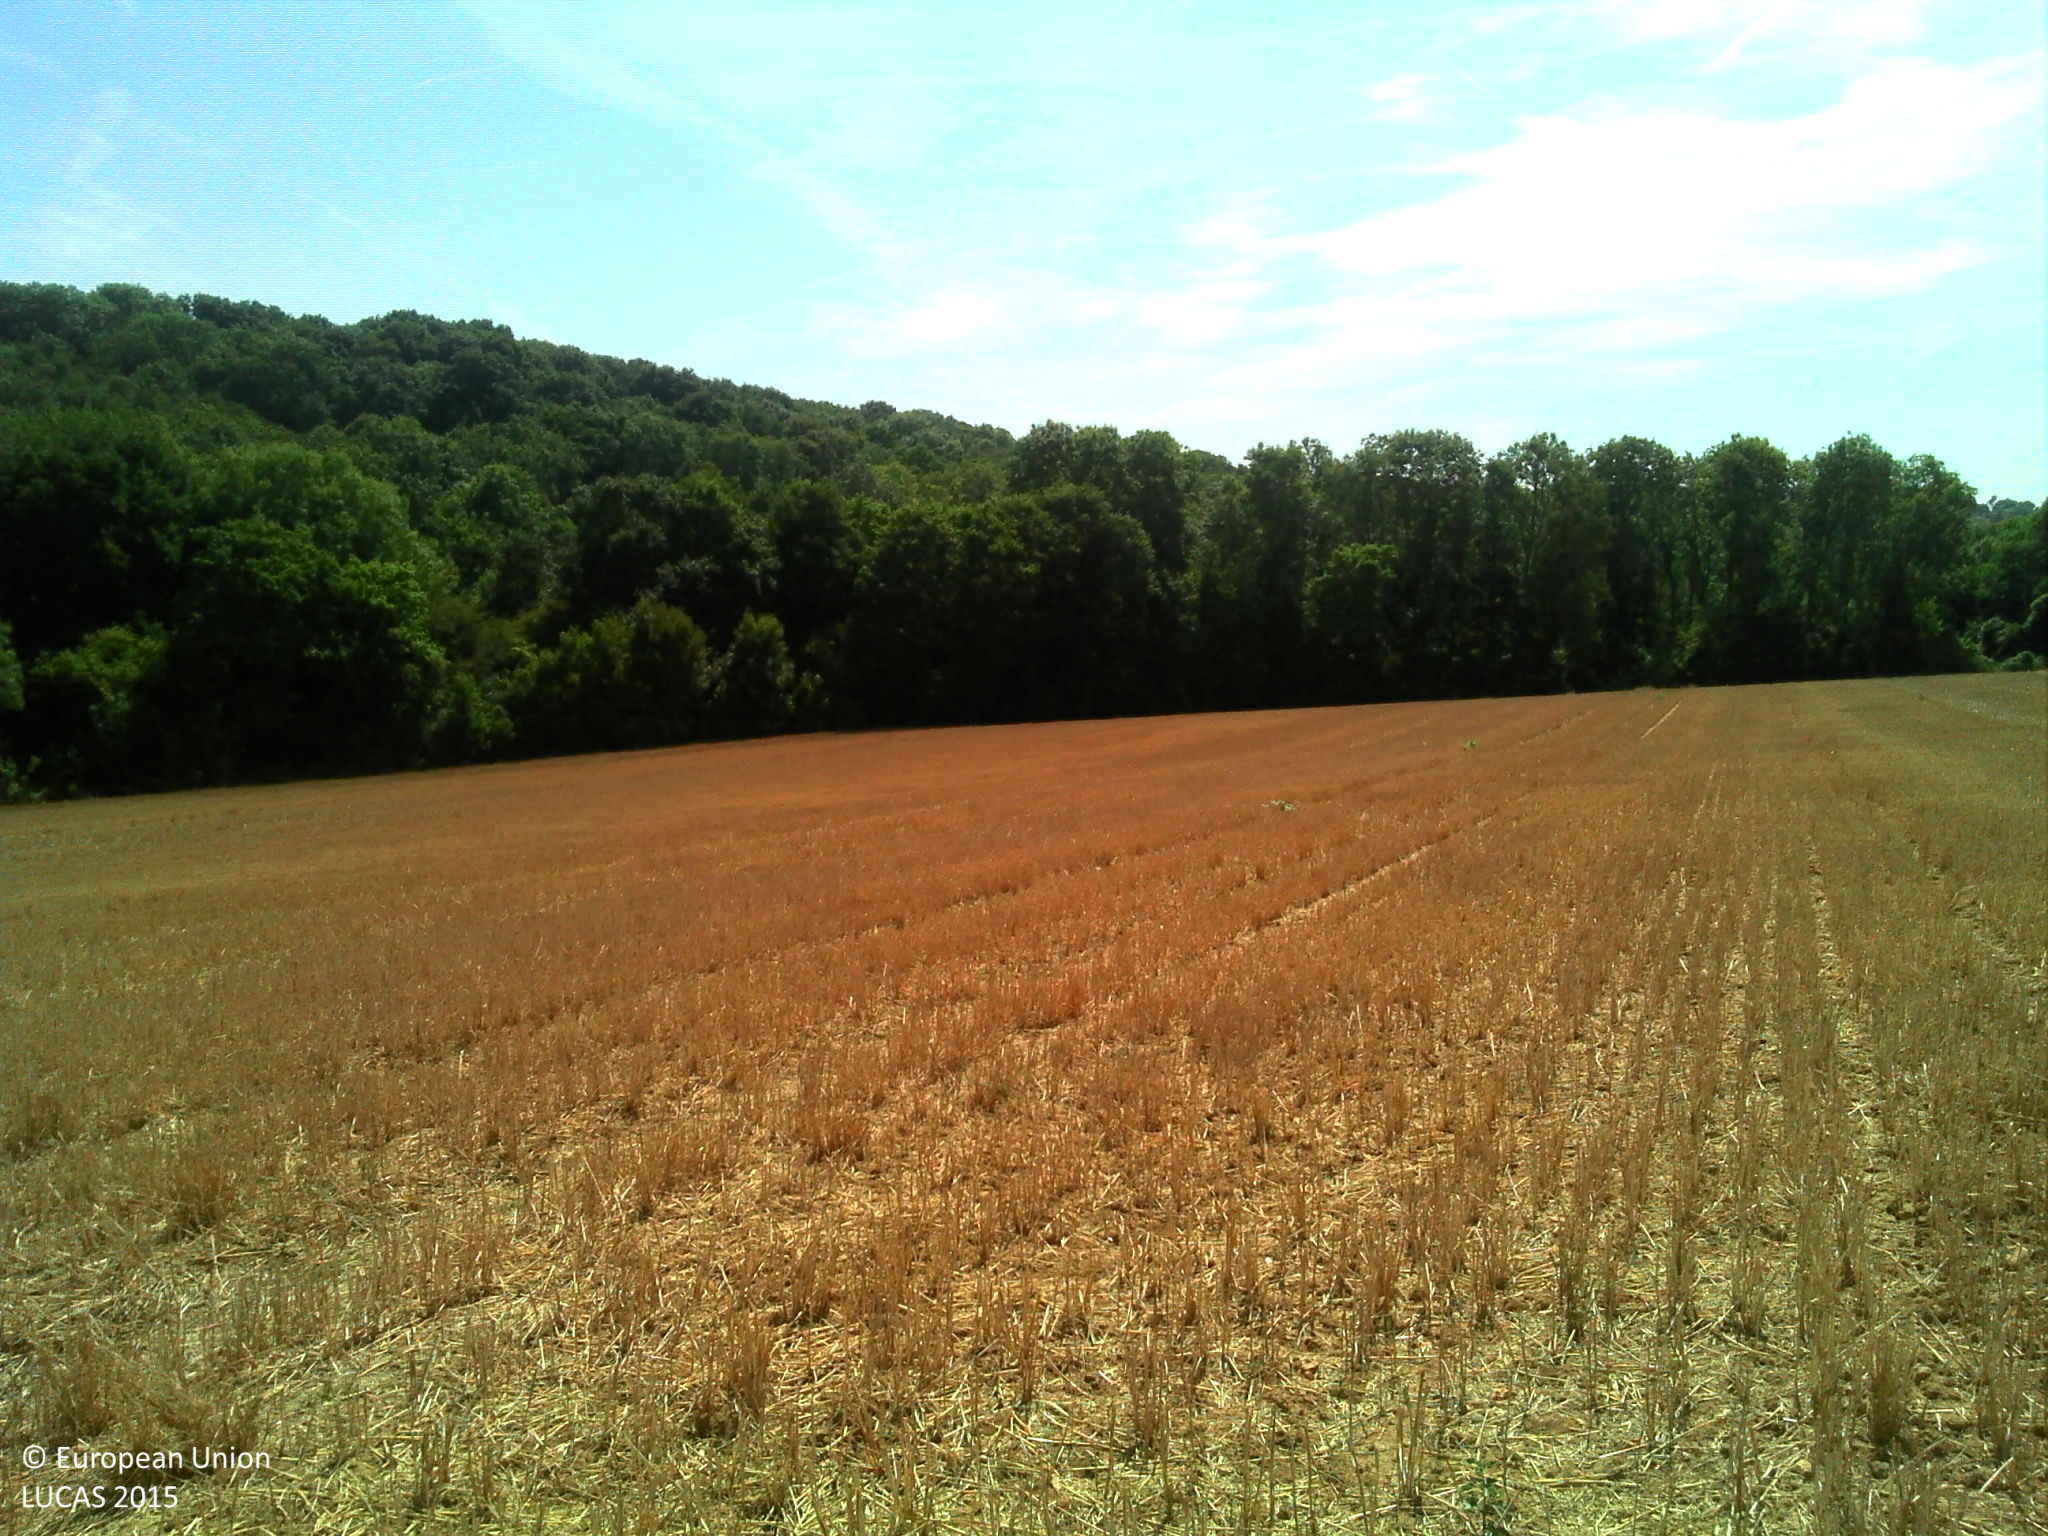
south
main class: Cropland
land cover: Common wheat
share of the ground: > 75 %
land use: Agriculture (excluding fallow land and kitchen gardens)
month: August
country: FR
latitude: 49.1235
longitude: 1.9691
